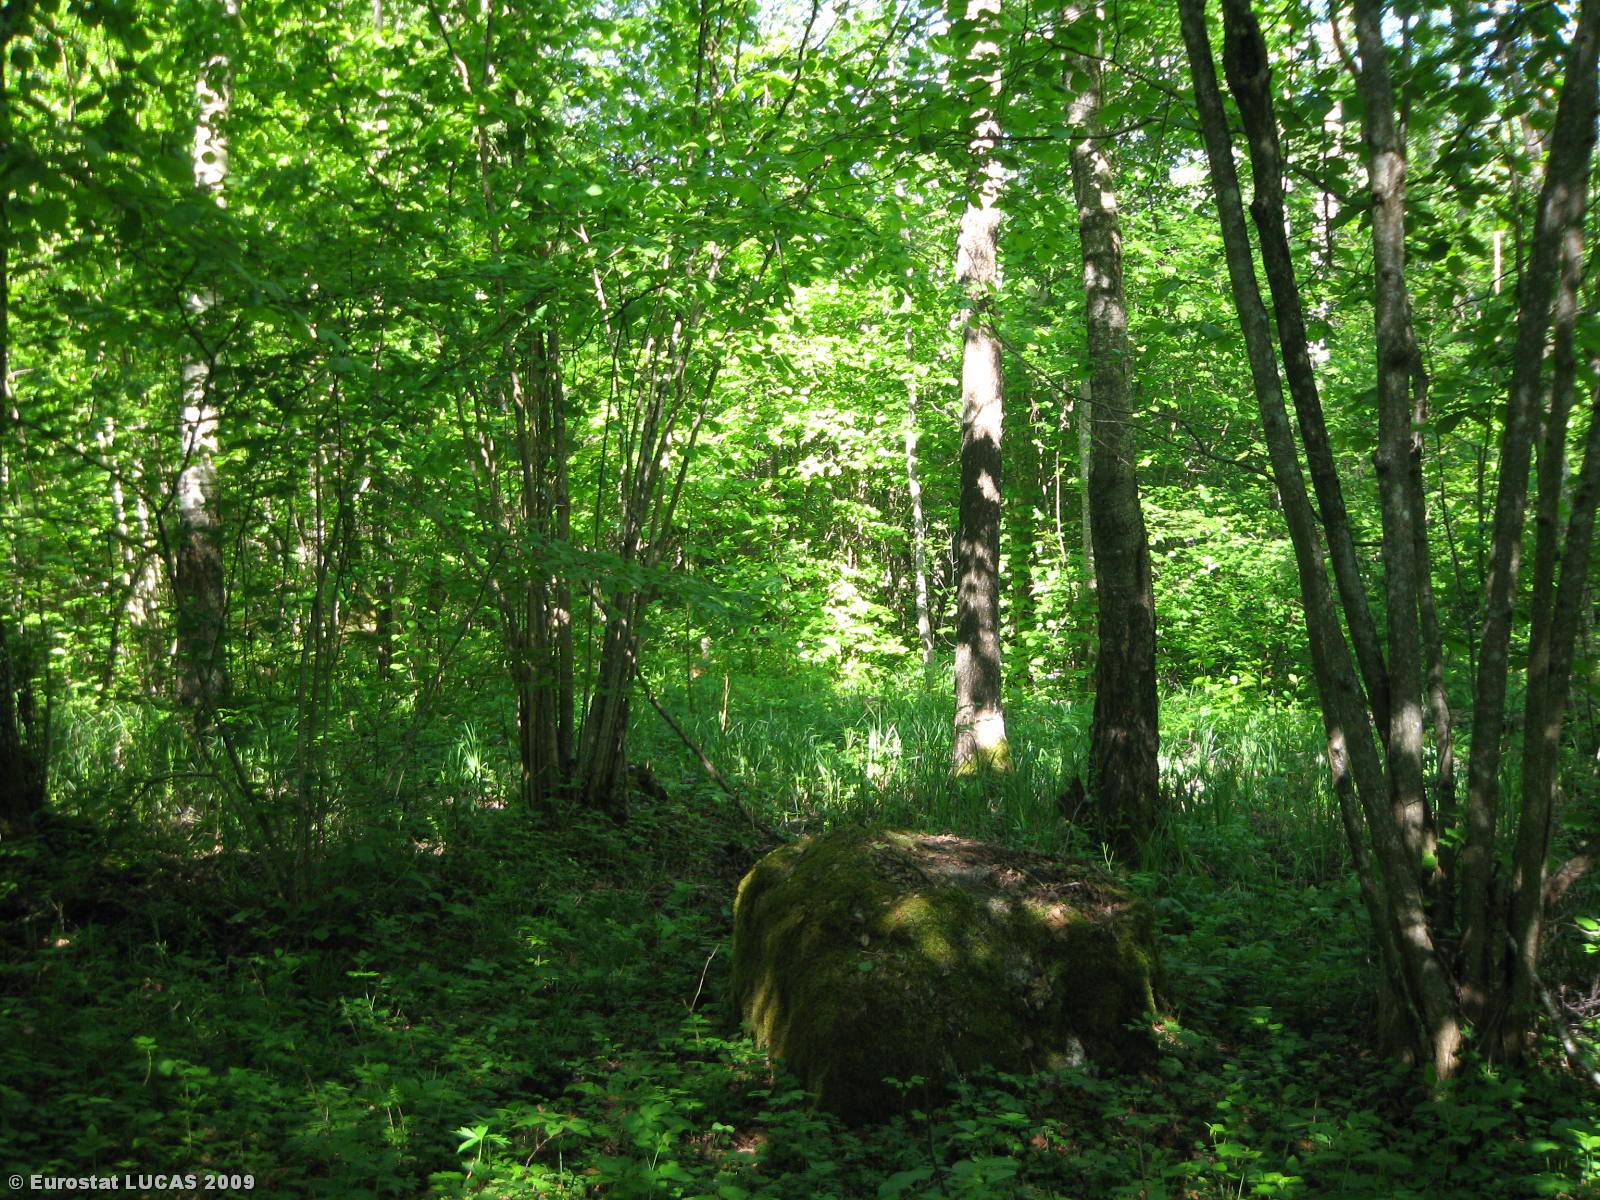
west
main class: Woodland
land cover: Broadleaved woodland
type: non-riverine alder, birch or aspen forest
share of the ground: > 75 %
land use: Forestry
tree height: > 5 m
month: May
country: LT
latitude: 55.7904
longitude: 24.0765
